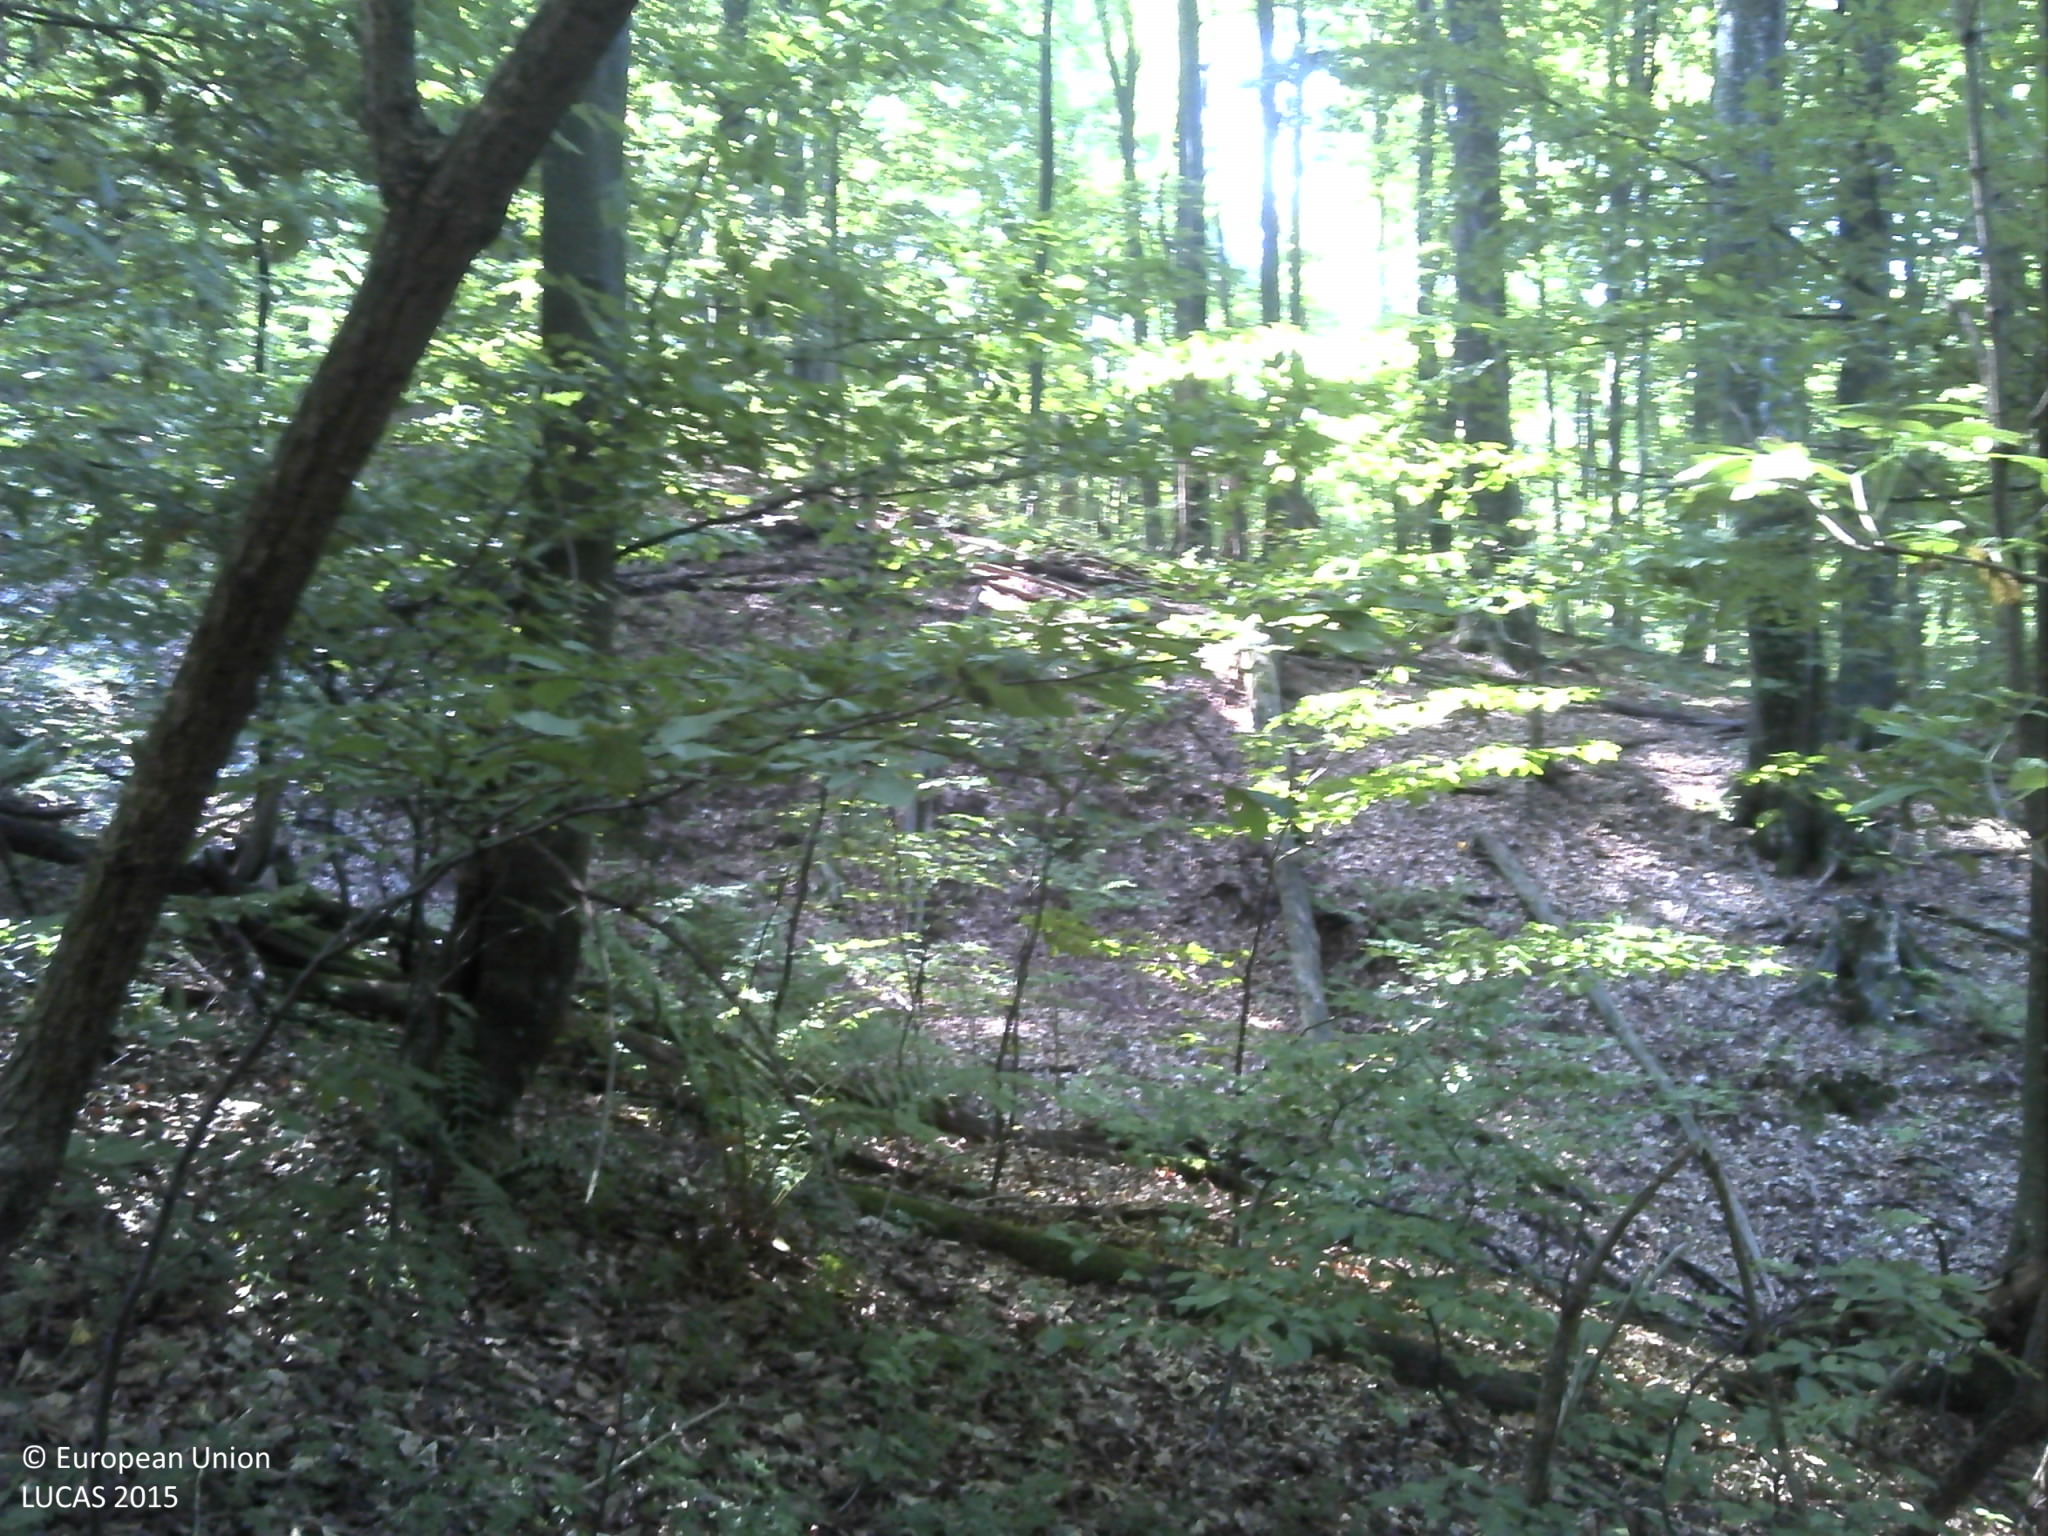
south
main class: Woodland
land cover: Broadleaved woodland
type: beech forest
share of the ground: > 75 %
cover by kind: broadleaved forest trees 100 %
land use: Forestry
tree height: > 5 m
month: August
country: HR
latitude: 45.2437
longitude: 16.3032
